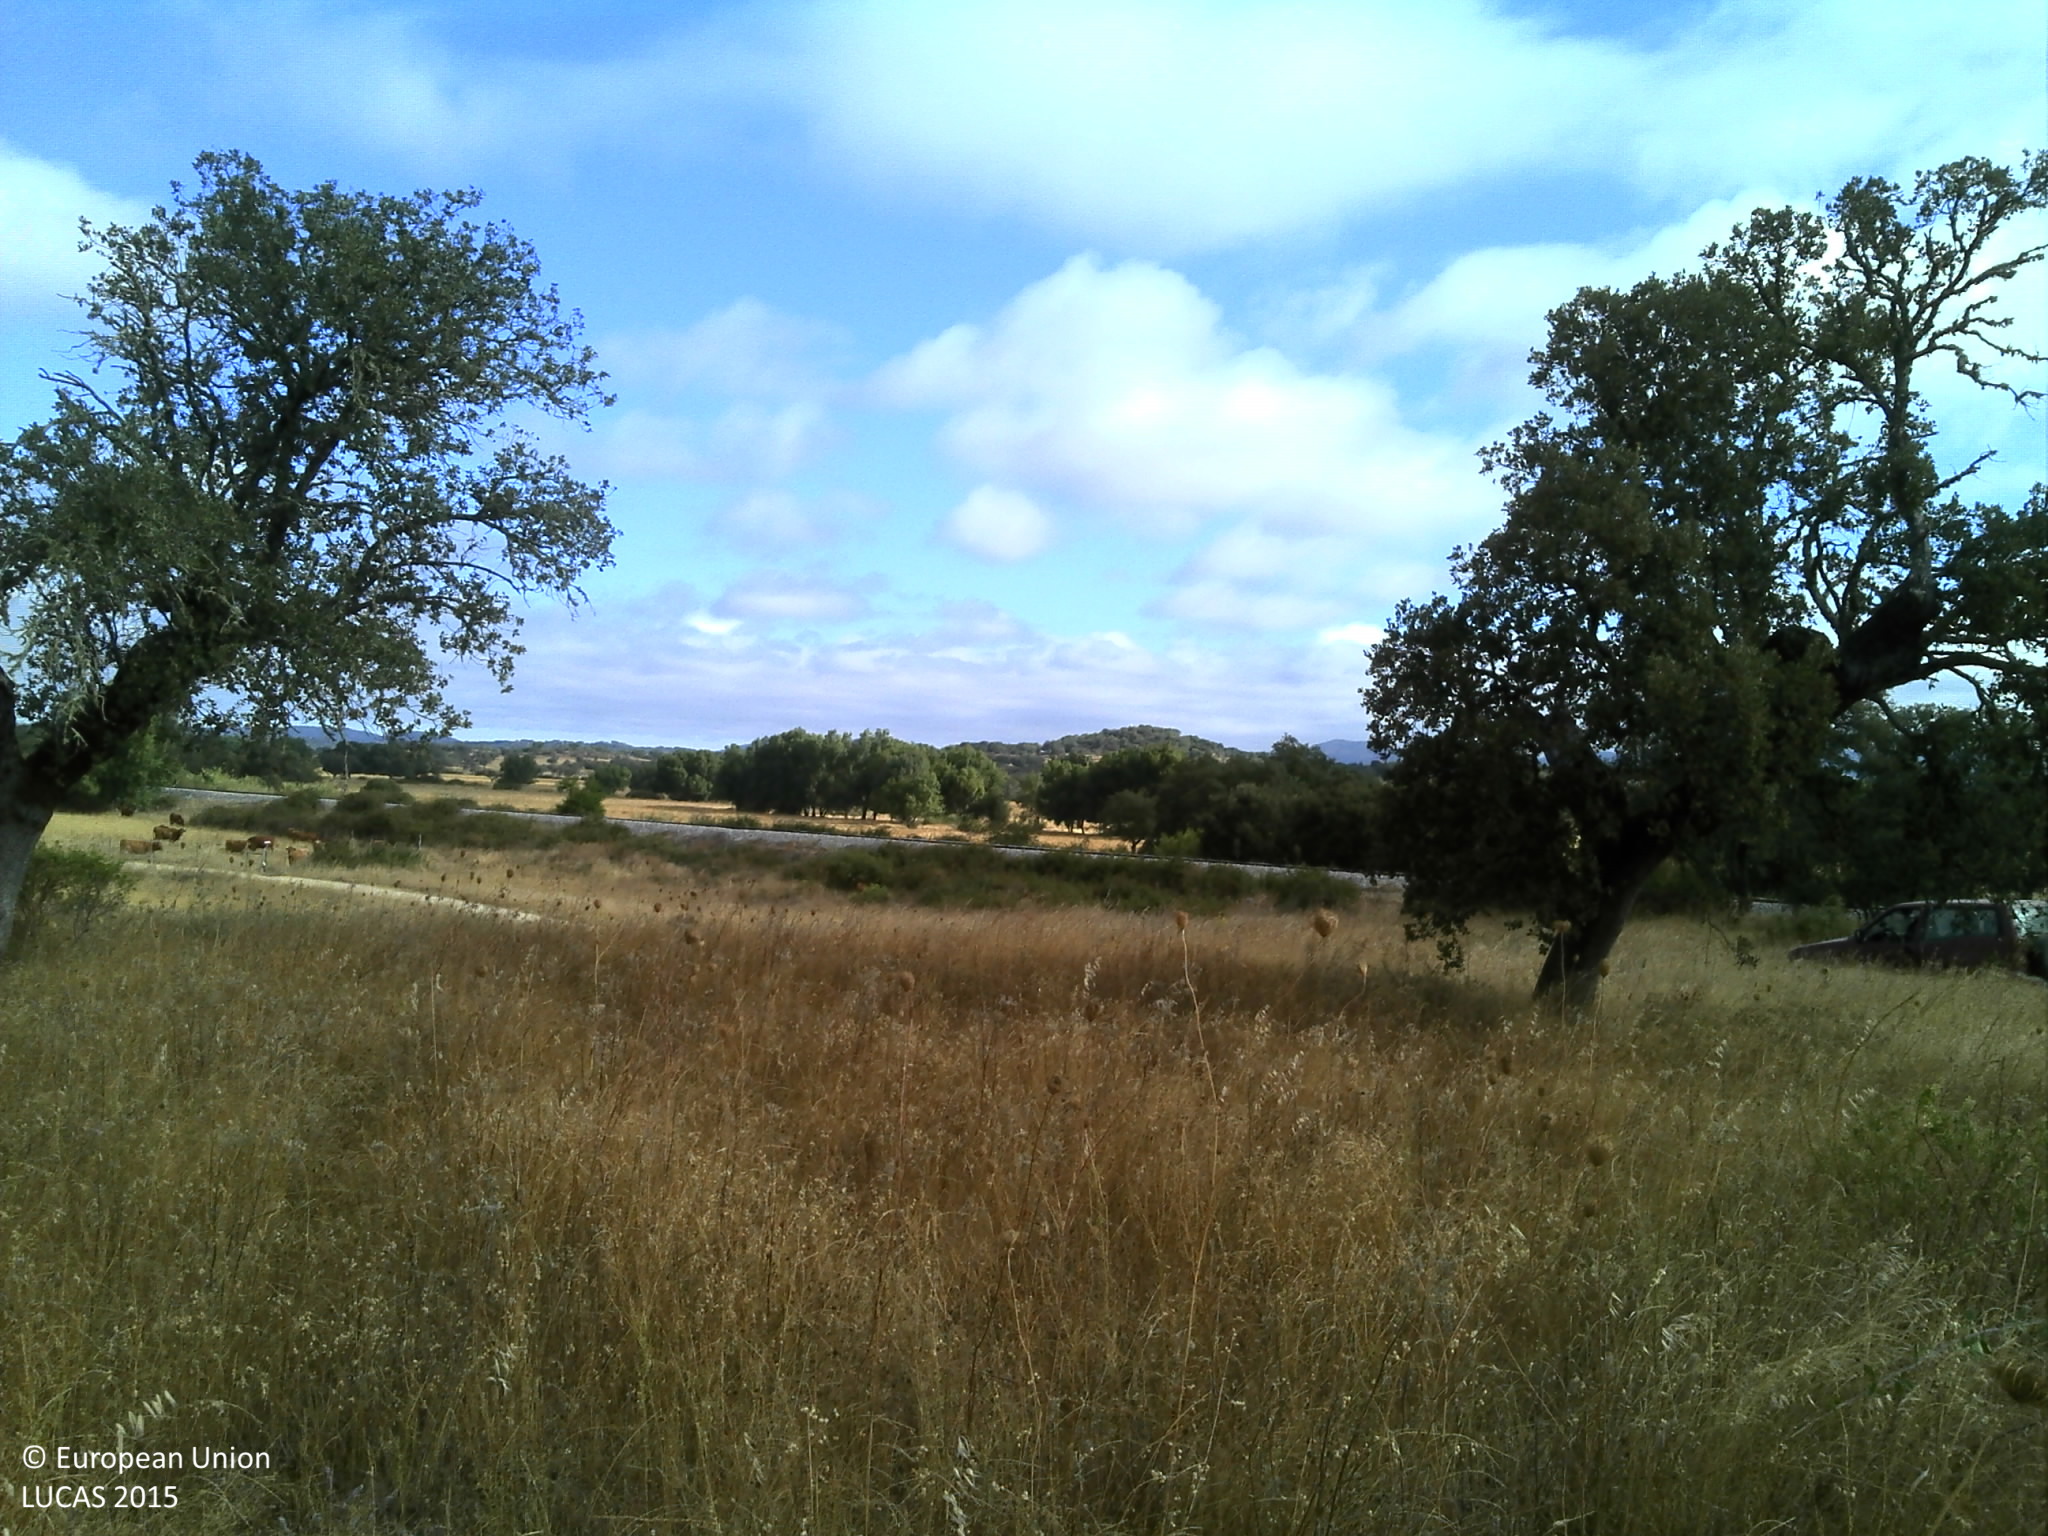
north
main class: Grassland
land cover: Grassland with sparse tree/shrub cover
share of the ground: > 75 %
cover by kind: herbaceous plants 70 %, unconsolidated bare surface 20 %, broadleaved forest trees 5 %, shrubs 5 %
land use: Agriculture (excluding fallow land and kitchen gardens)
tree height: < 5 m
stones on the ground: < 10 %
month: July
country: PT
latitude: 39.2033
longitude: -7.4685
